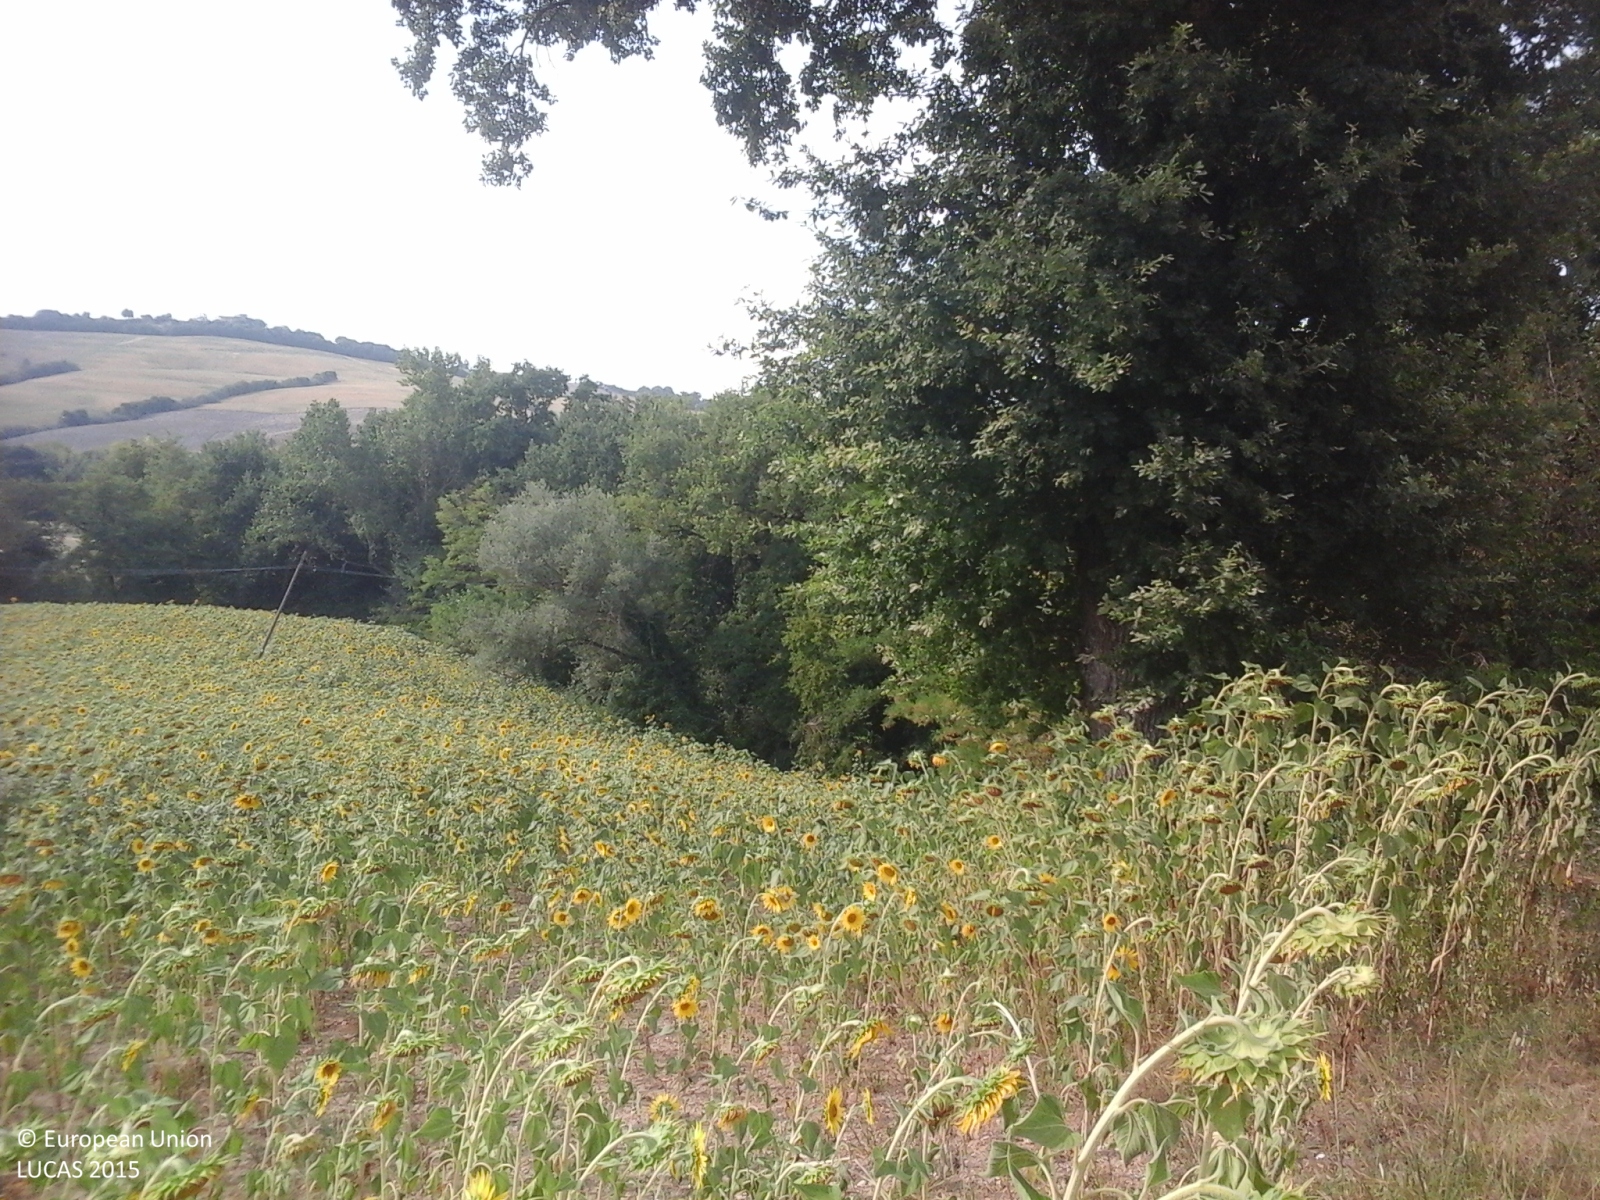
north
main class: Cropland
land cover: Sunflower
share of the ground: > 75 %
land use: Agriculture (excluding fallow land and kitchen gardens)
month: July
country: IT
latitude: 43.1925
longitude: 13.4241
